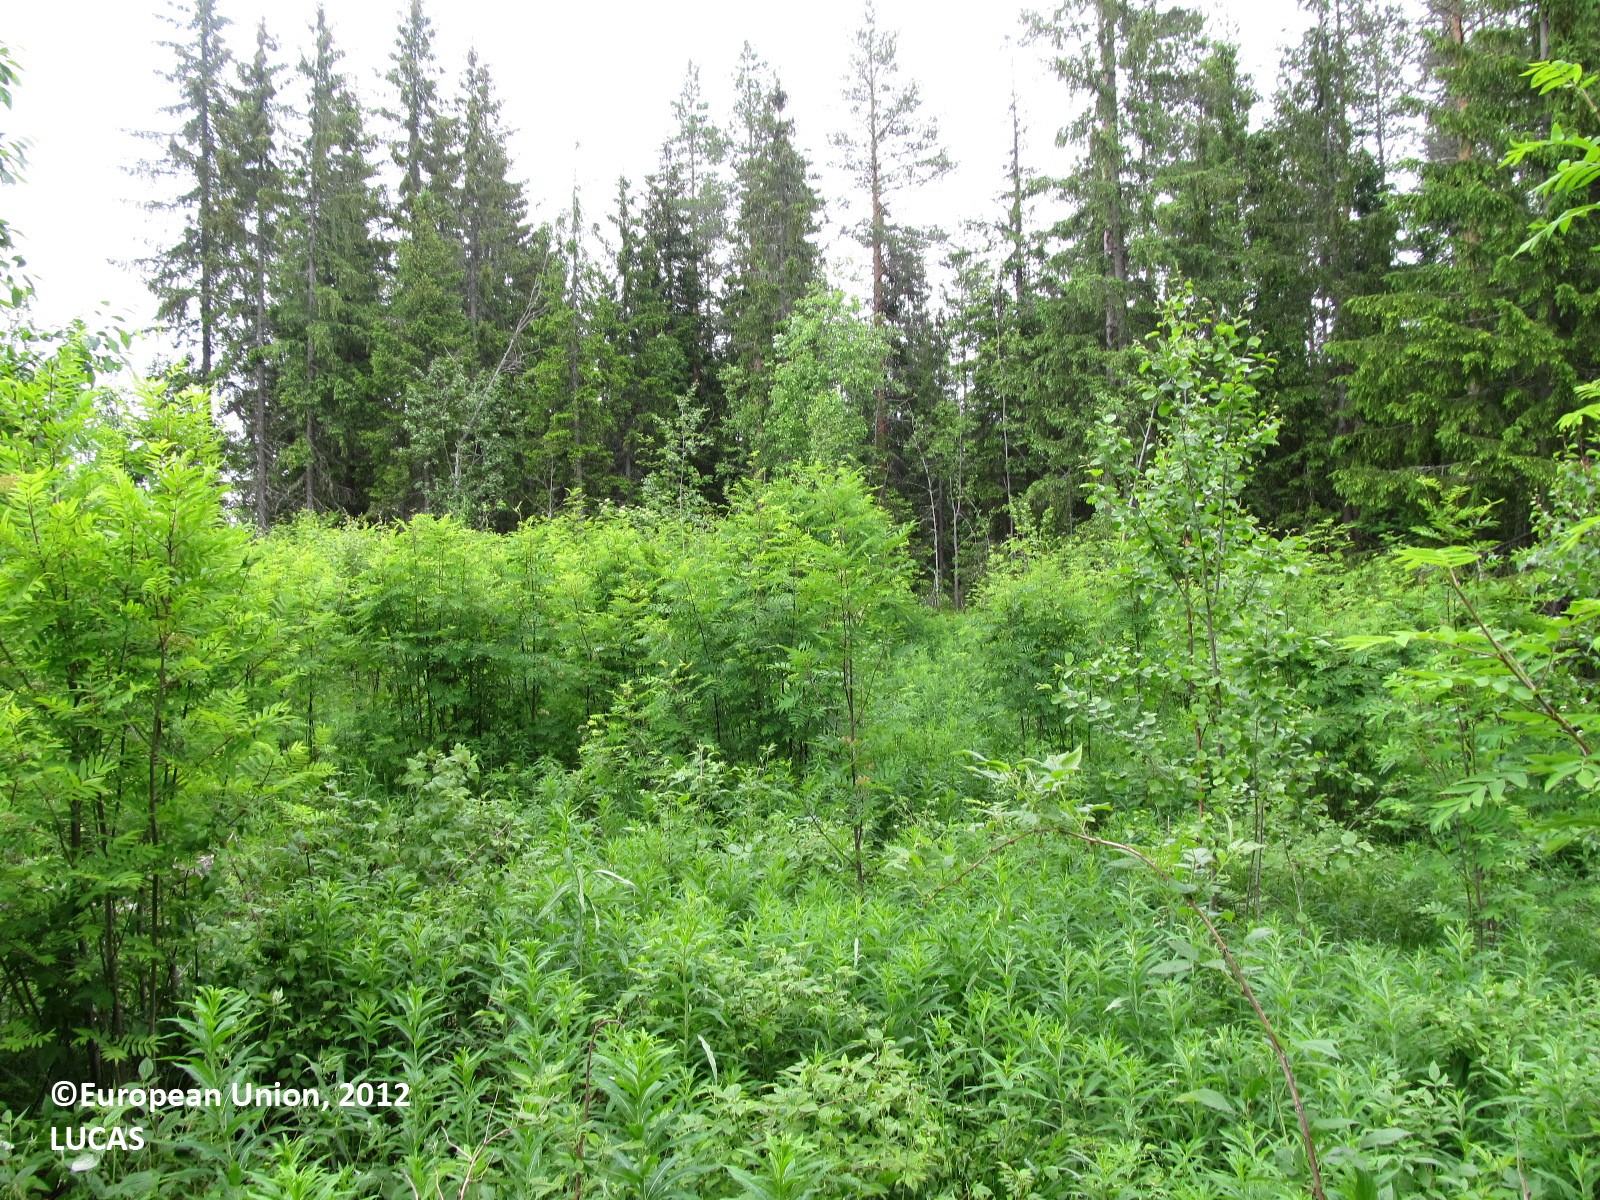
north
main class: Woodland
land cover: Broadleaved woodland
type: boreal forest
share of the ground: 50 - 75 %
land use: Forestry
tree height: < 5 m
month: June
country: FI
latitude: 63.1886
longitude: 27.6721
